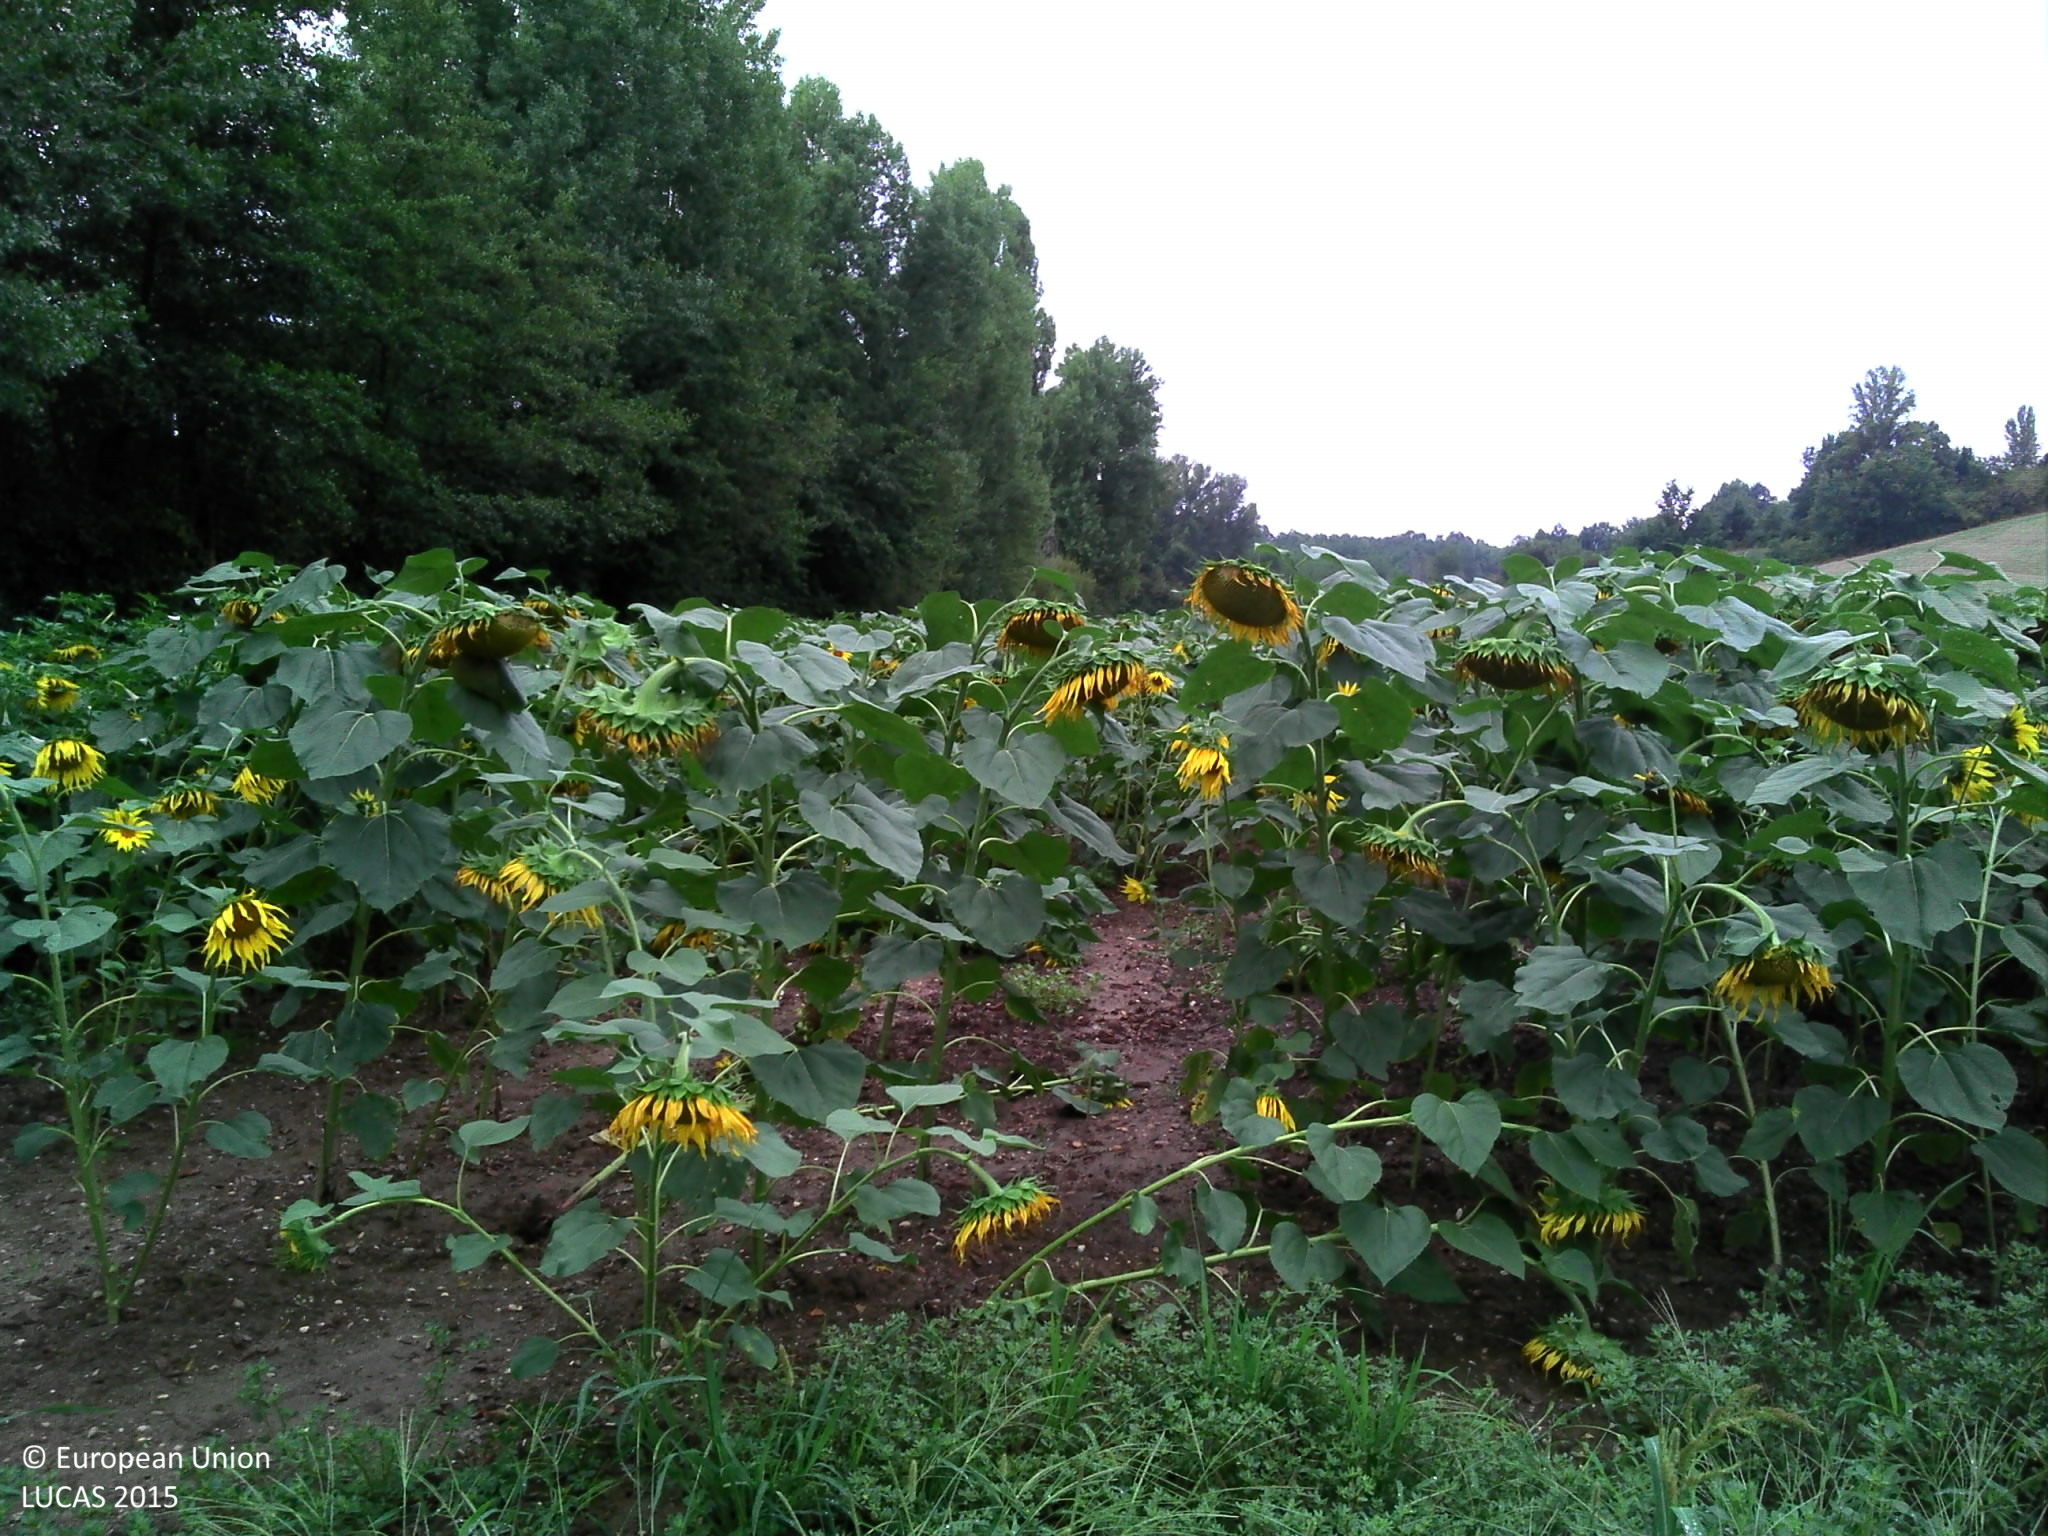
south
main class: Cropland
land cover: Maize
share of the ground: > 75 %
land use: Agriculture (excluding fallow land and kitchen gardens)
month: August
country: FR
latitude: 44.0040
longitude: 1.5326
